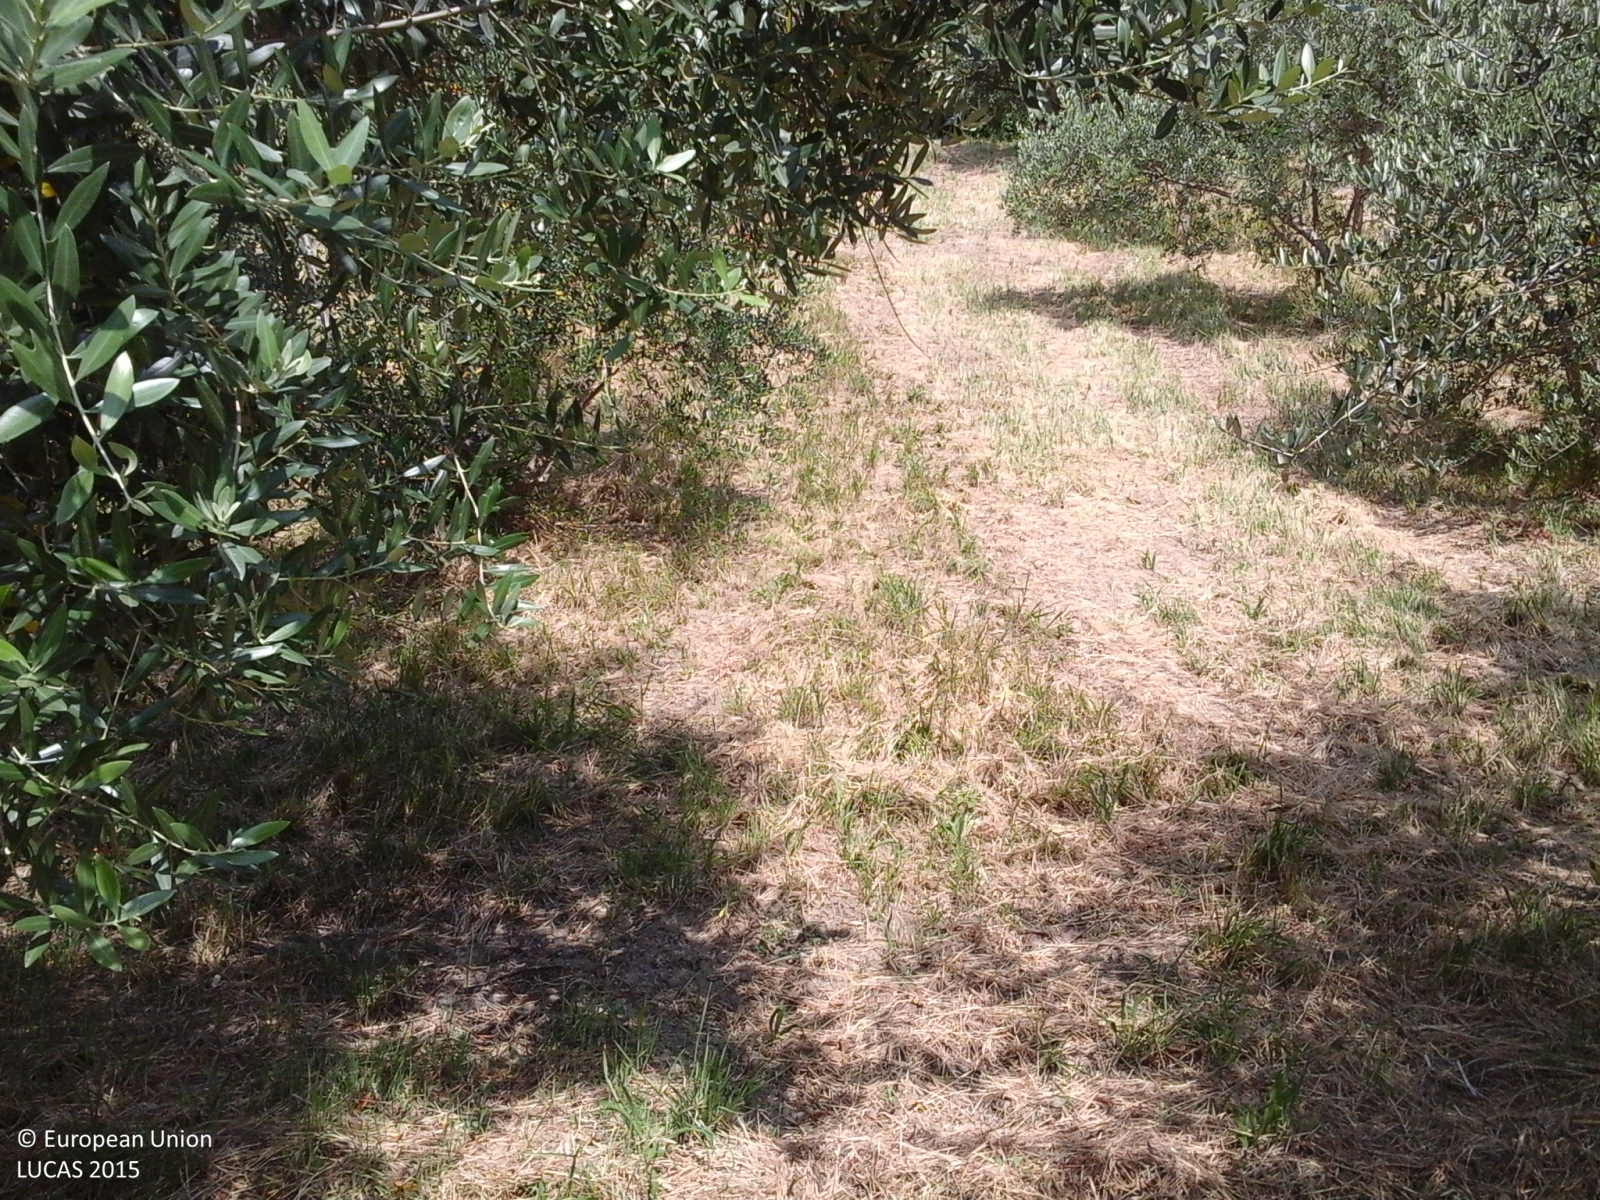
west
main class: Shrubland
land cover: Shrubland with sparse tree cover
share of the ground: > 75 %
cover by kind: shrubs 95 %, coniferous forest trees 5 %
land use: Abandoned areas
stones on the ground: < 10 %
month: July
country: IT
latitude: 44.0915
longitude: 12.2555
